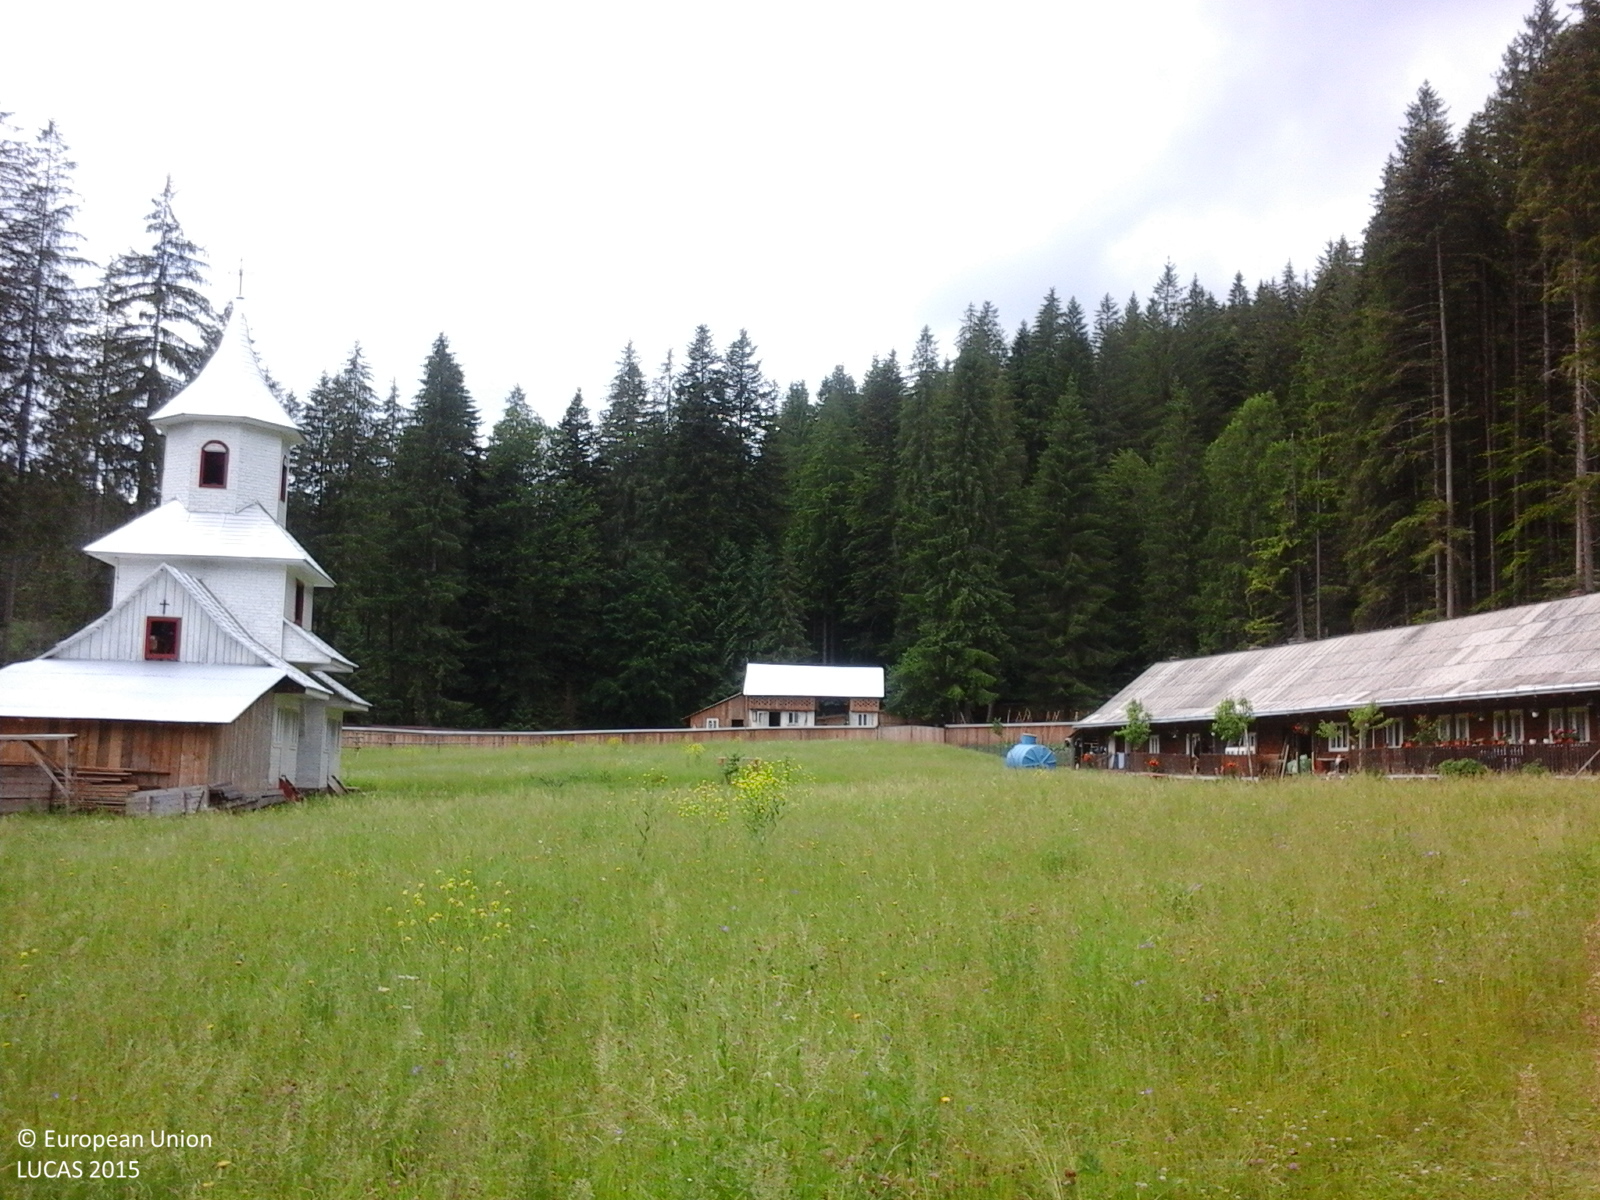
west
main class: Grassland
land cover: Grassland without tree/shrub cover
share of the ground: > 75 %
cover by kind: herbaceous plants 100 %
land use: Community services
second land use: Amenities, museums, leisure
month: June
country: RO
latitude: 46.7433
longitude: 26.0533
